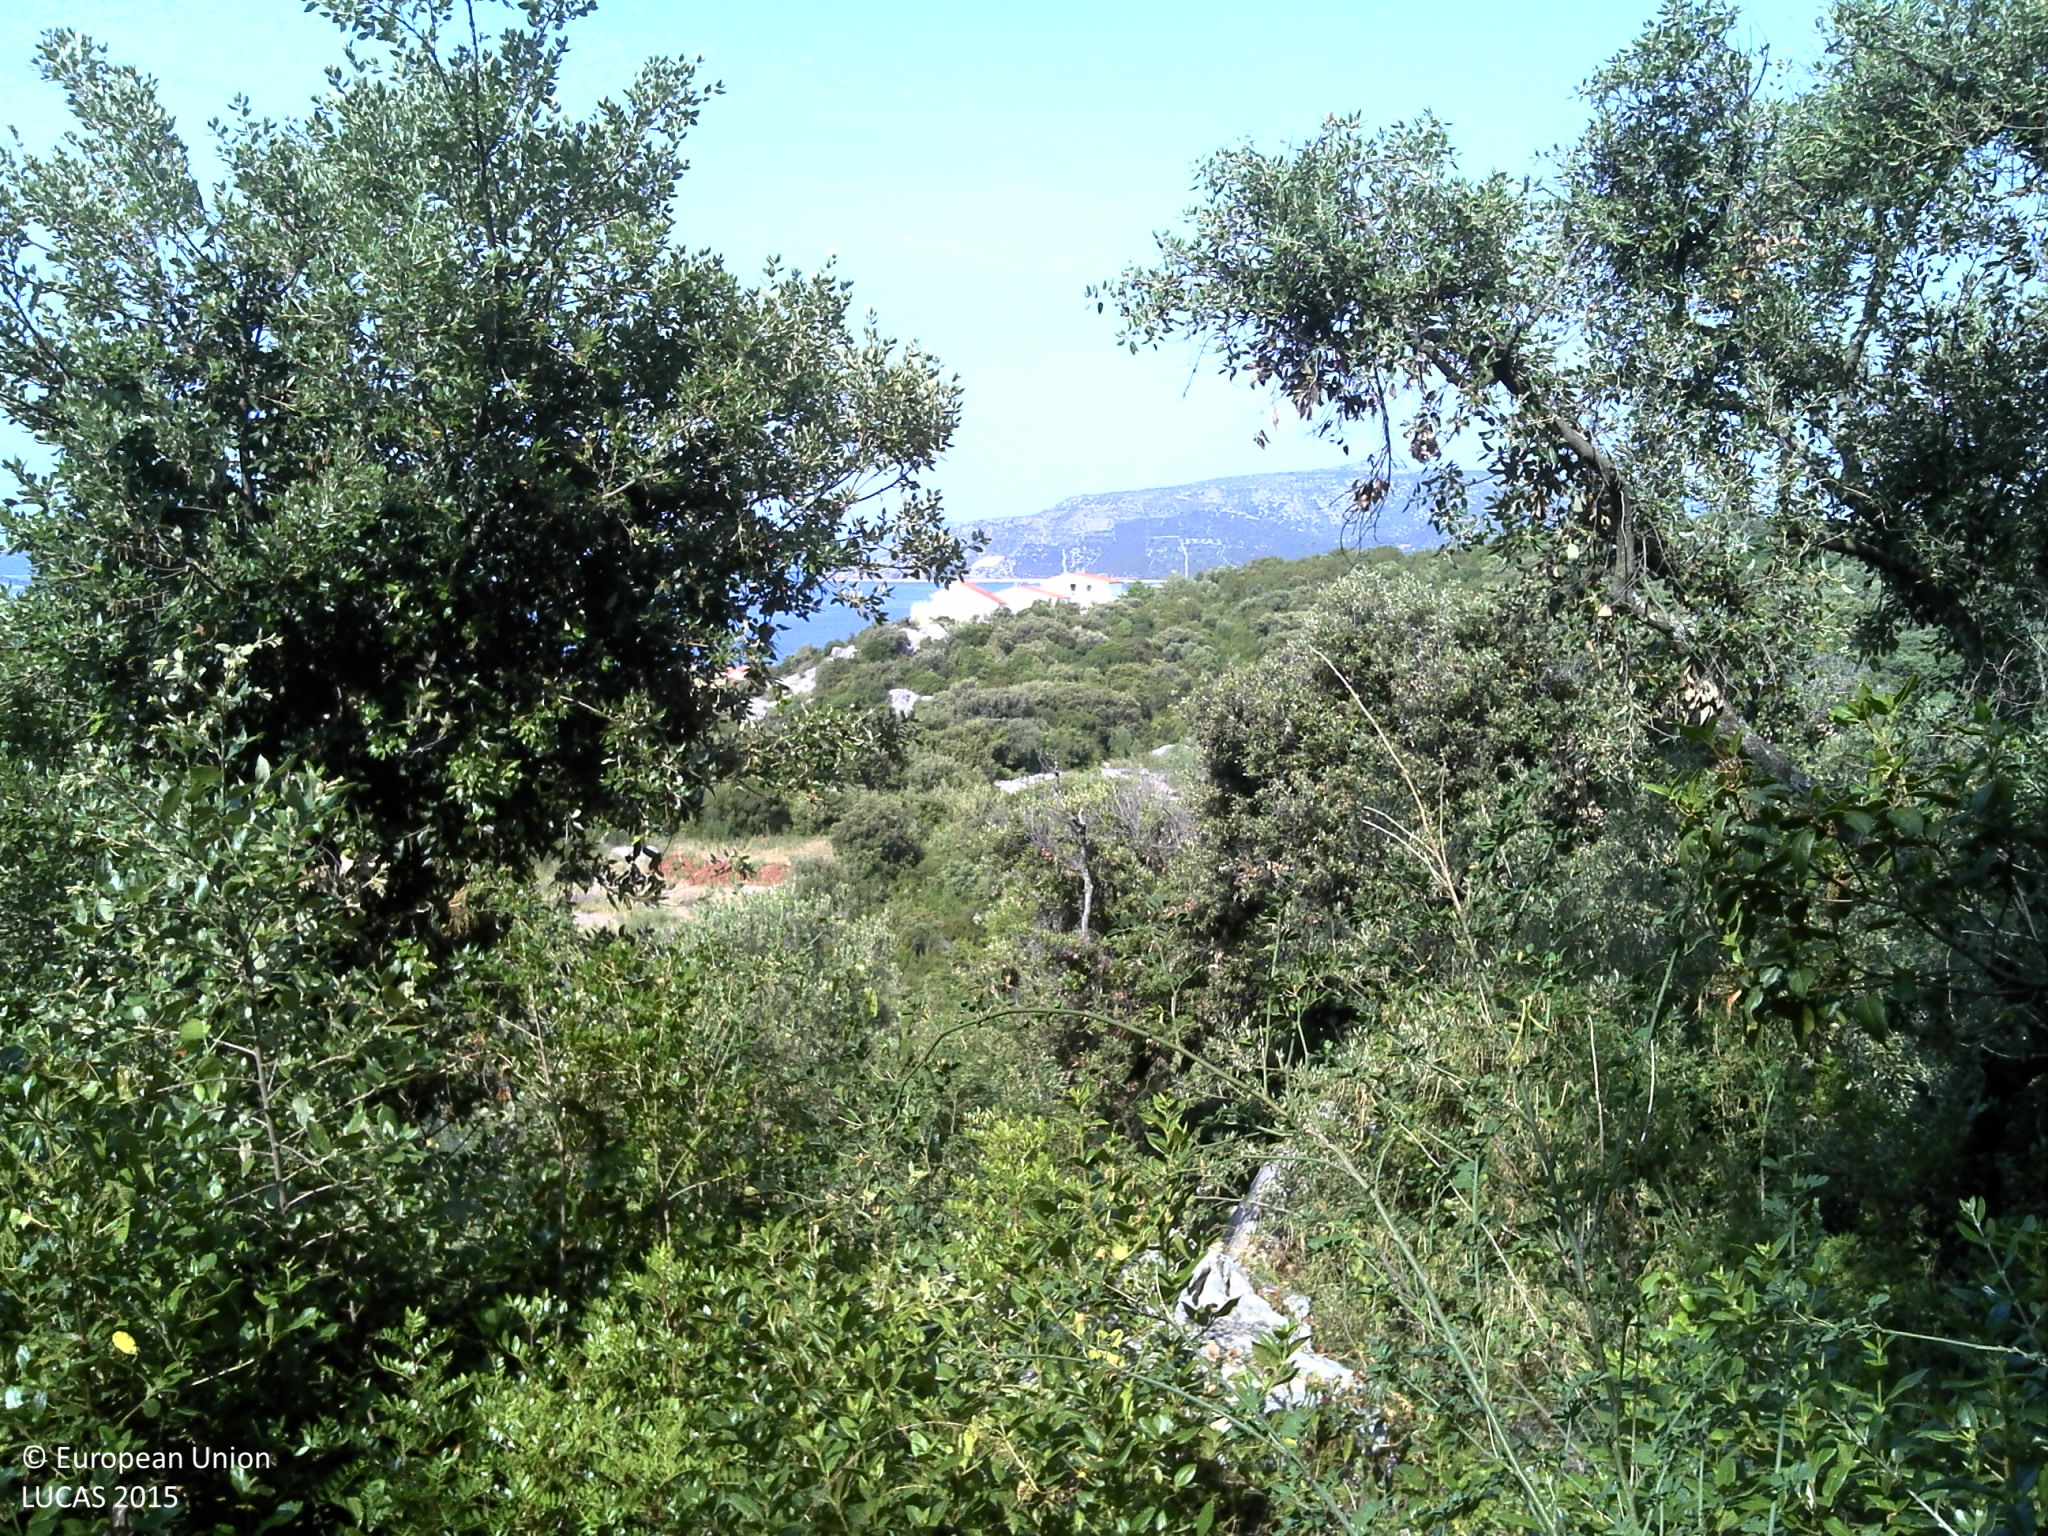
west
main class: Woodland
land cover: Broadleaved woodland
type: thermophilous deciduous forest
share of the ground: 25 - 50 %
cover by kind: broadleaved forest trees 40 %, shrubs 30 %, consolidated bare surface 20 %, unconsolidated bare surface 10 %
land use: Semi-natural and natural areas not in use
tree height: > 5 m
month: June
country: HR
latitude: 43.4952
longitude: 16.2108
